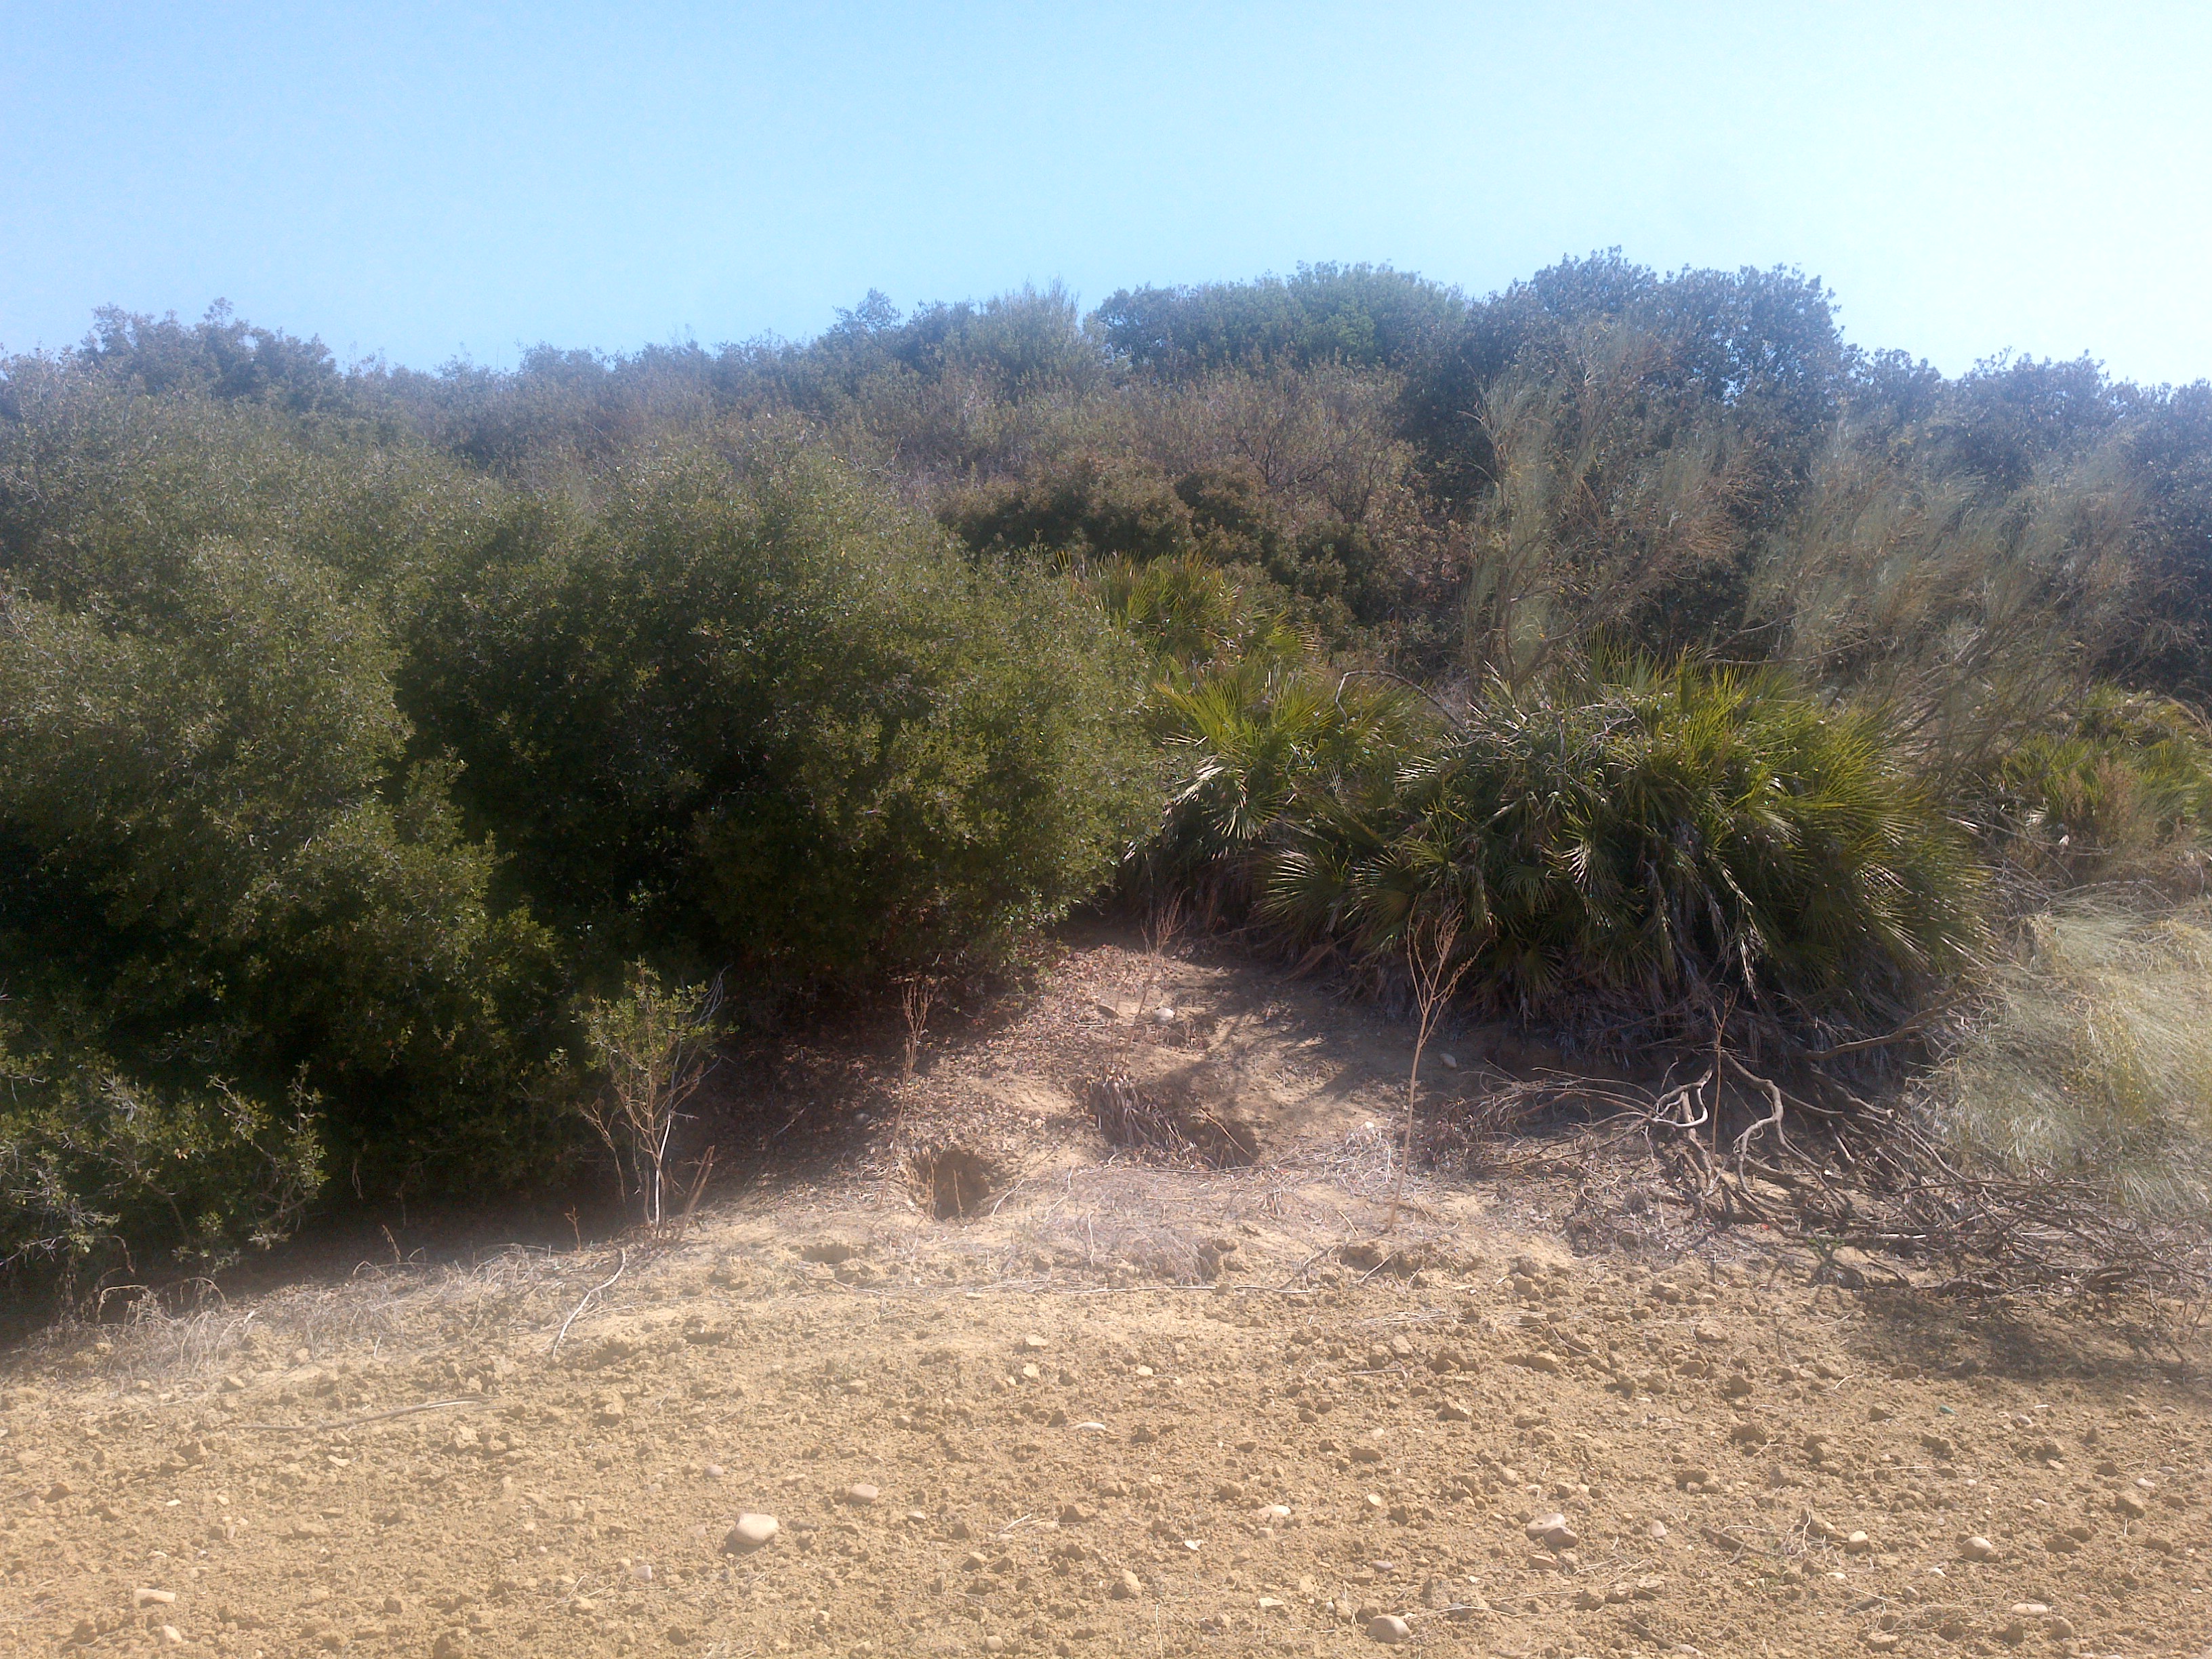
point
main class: Woodland
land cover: Broadleaved woodland
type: broadleaved evergreen forest
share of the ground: 25 - 50 %
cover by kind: shrubs 50 %, broadleaved forest trees 25 %, unconsolidated bare surface 15 %, herbaceous plants 10 %
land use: Semi-natural and natural areas not in use
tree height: < 5 m
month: June
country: ES
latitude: 37.7241
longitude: -4.9101
